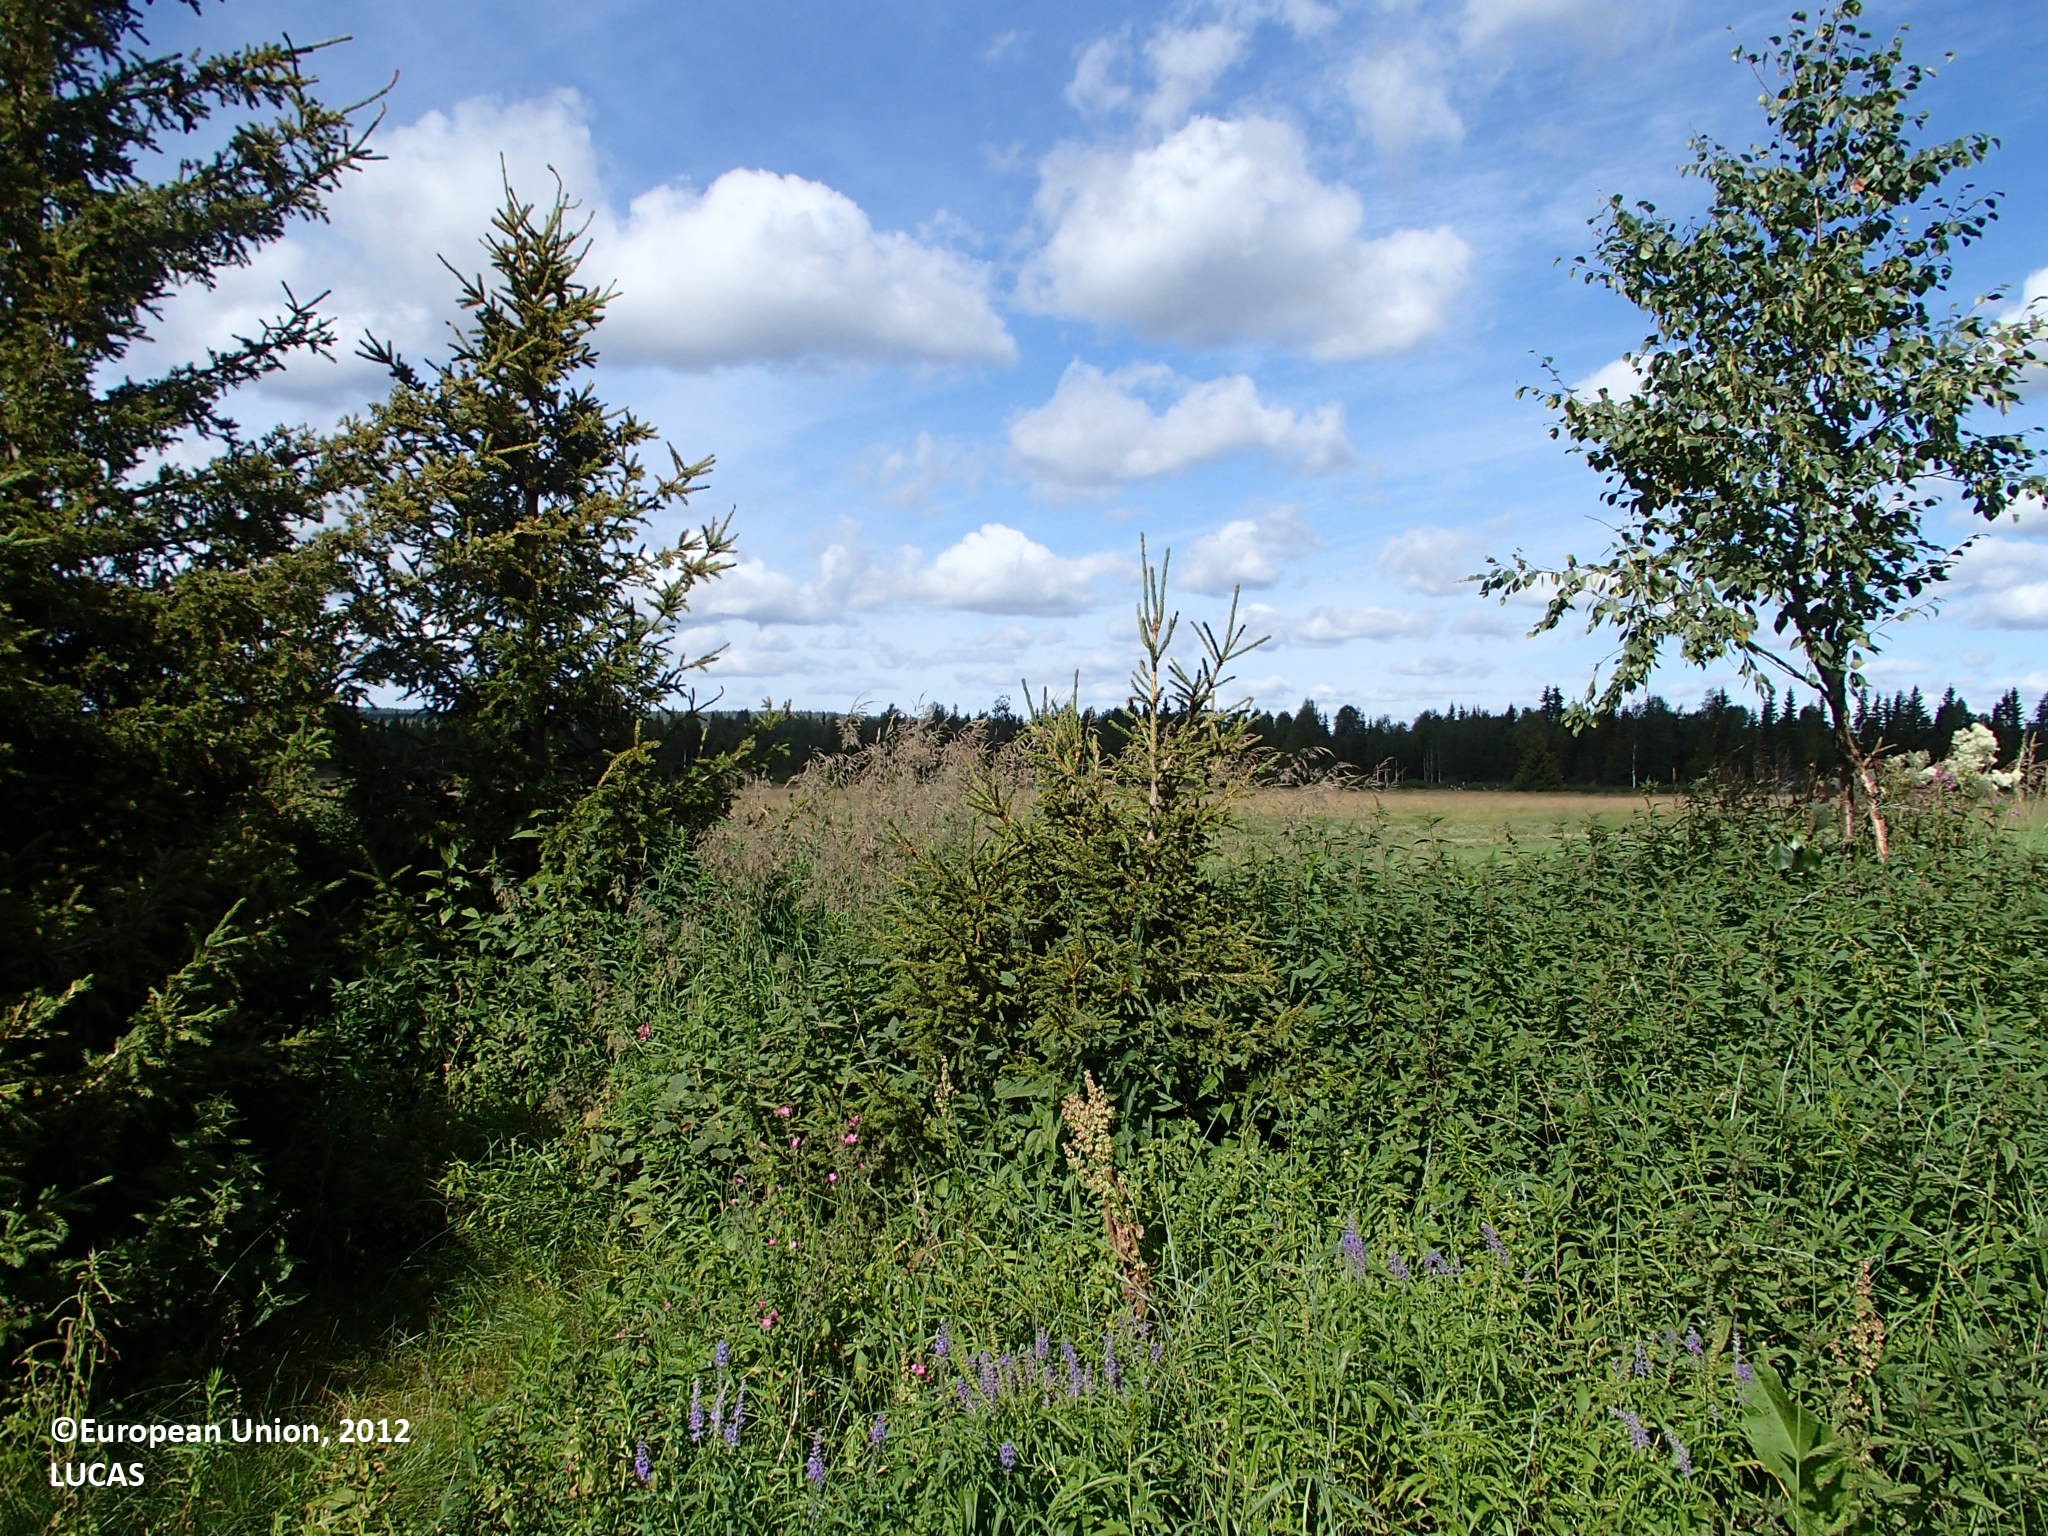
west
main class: Woodland
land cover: Spruce dominated coniferous woodland
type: boreal forest
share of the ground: 25 - 50 %
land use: Forestry
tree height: > 5 m
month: August
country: FI
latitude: 66.2372
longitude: 25.5249
